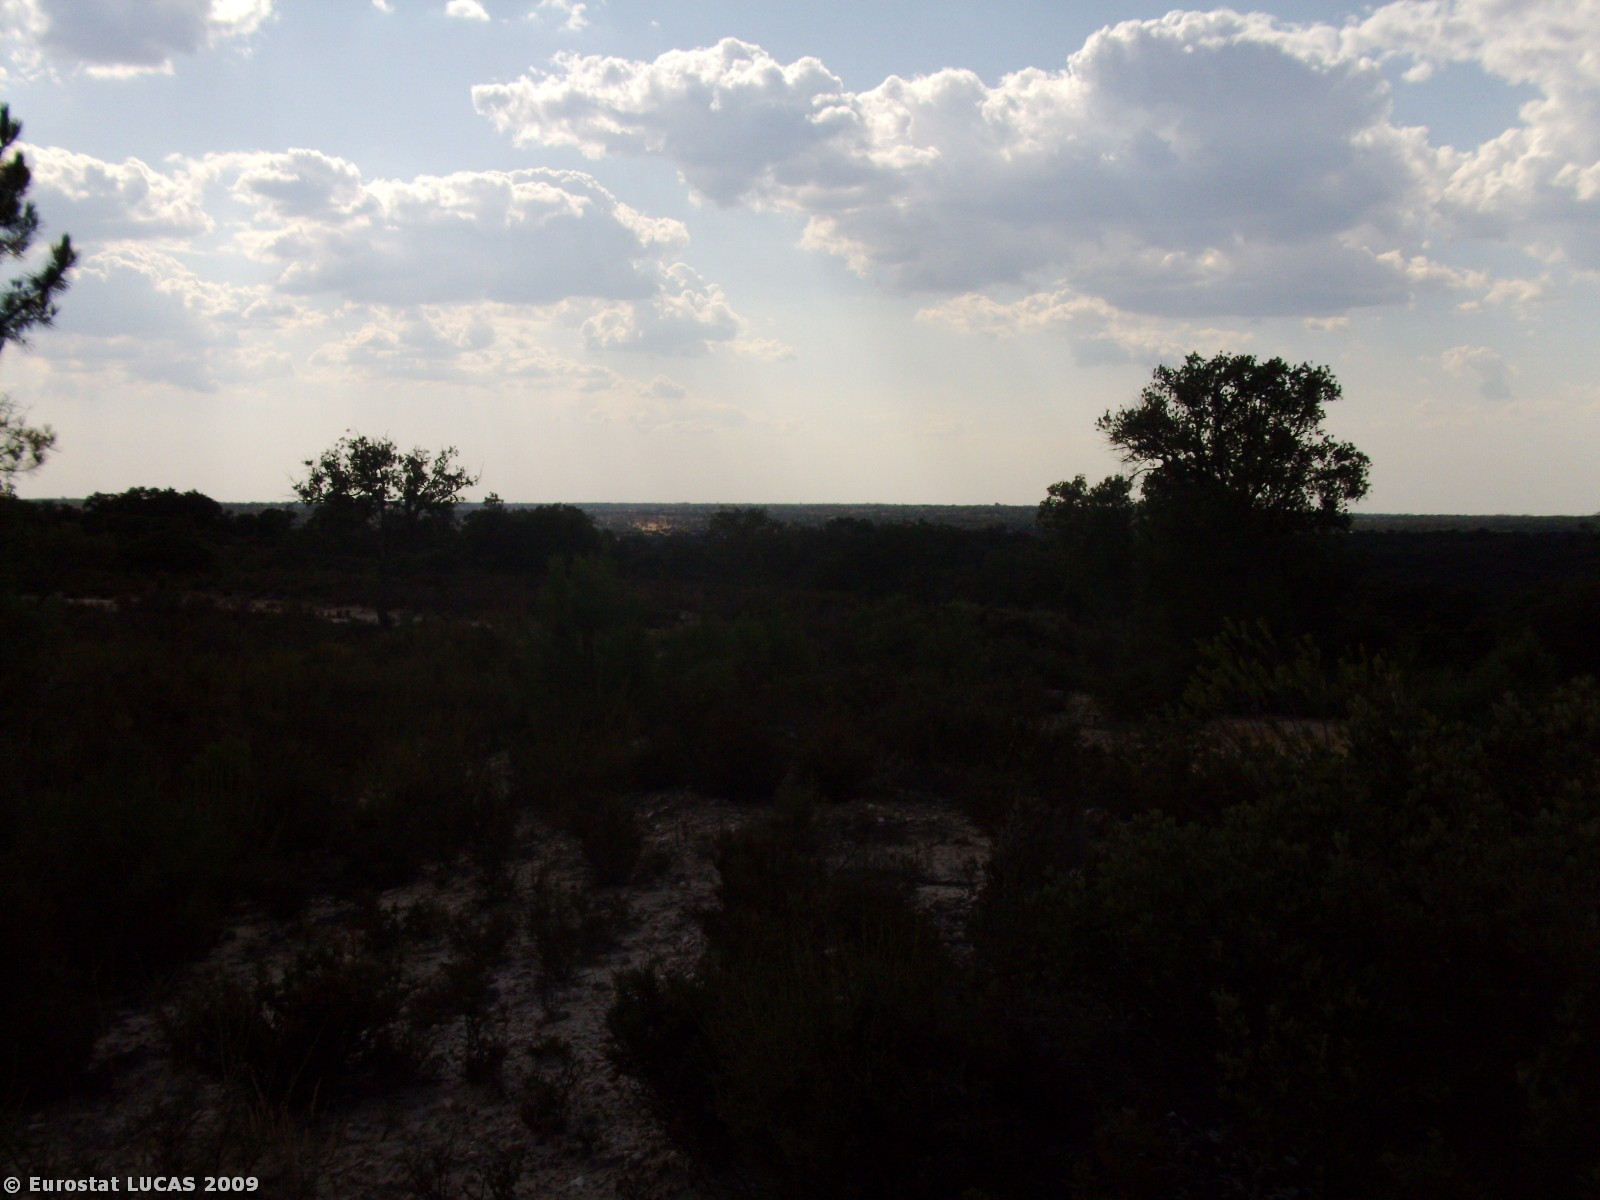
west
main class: Woodland
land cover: Mixed woodland
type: hemiboreal forest and nemoral coniferous forest and mixed broadleaved-coniferous forest
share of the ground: 10 - 25 %
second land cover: Spontaneously vegetated surfaces
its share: 50 - 75 %
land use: Forestry
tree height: > 5 m
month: August
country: PT
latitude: 39.1951
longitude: -8.1073
